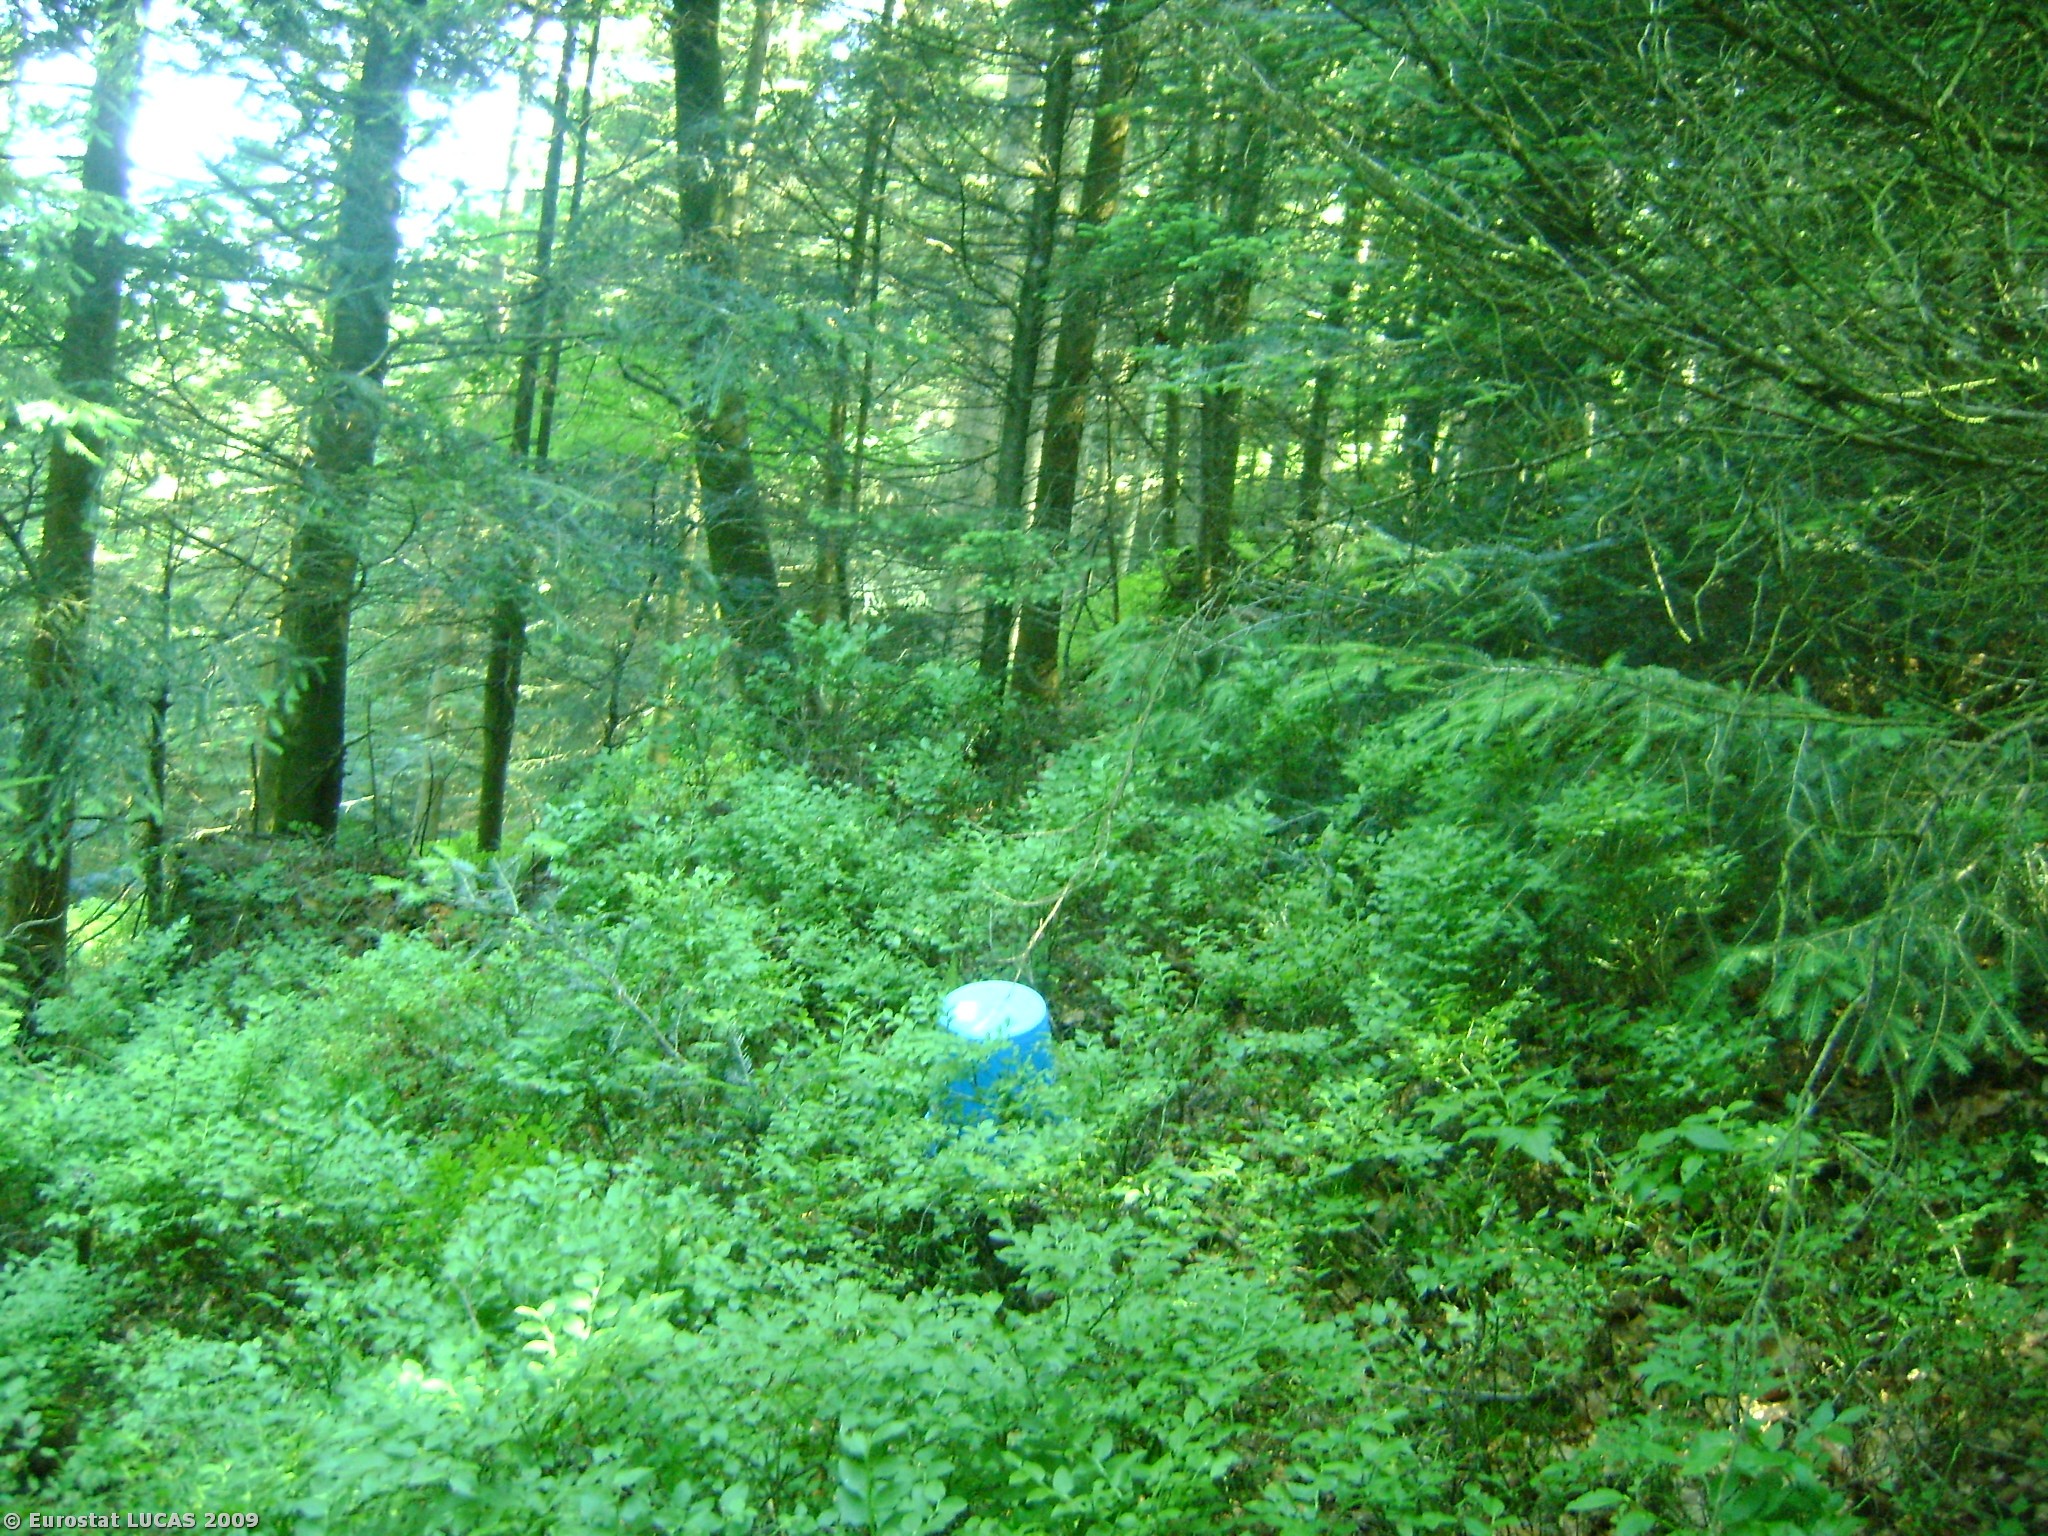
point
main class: Woodland
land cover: Coniferous woodland
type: hemiboreal forest and nemoral coniferous forest and mixed broadleaved-coniferous forest
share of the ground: > 75 %
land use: Forestry
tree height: > 5 m
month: June
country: AT
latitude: 48.0314
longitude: 13.2577
